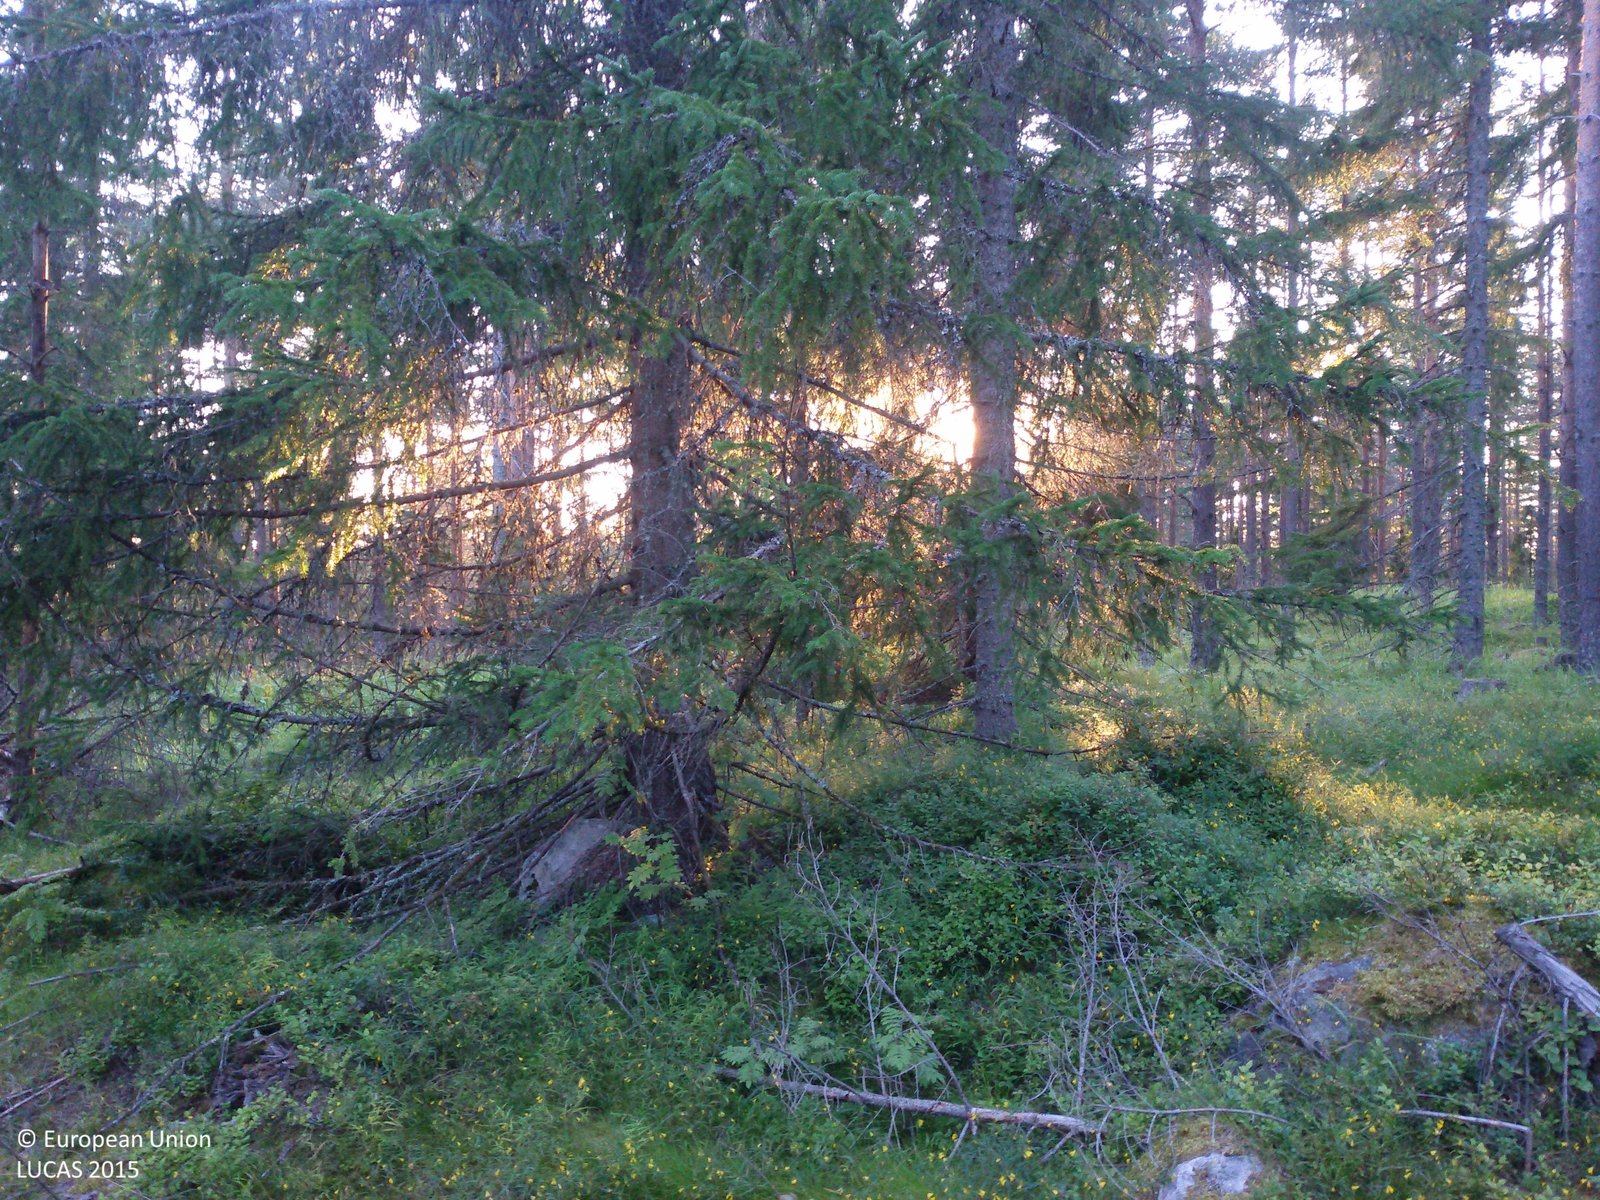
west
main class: Woodland
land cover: Other coniferous woodland
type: boreal forest
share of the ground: 50 - 75 %
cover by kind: coniferous forest trees 60 %, herbaceous plants 25 %, lichens and mosses 15 %
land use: Forestry
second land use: Other primary production
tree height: > 5 m
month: August
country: SE
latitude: 60.7862
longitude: 16.5814
